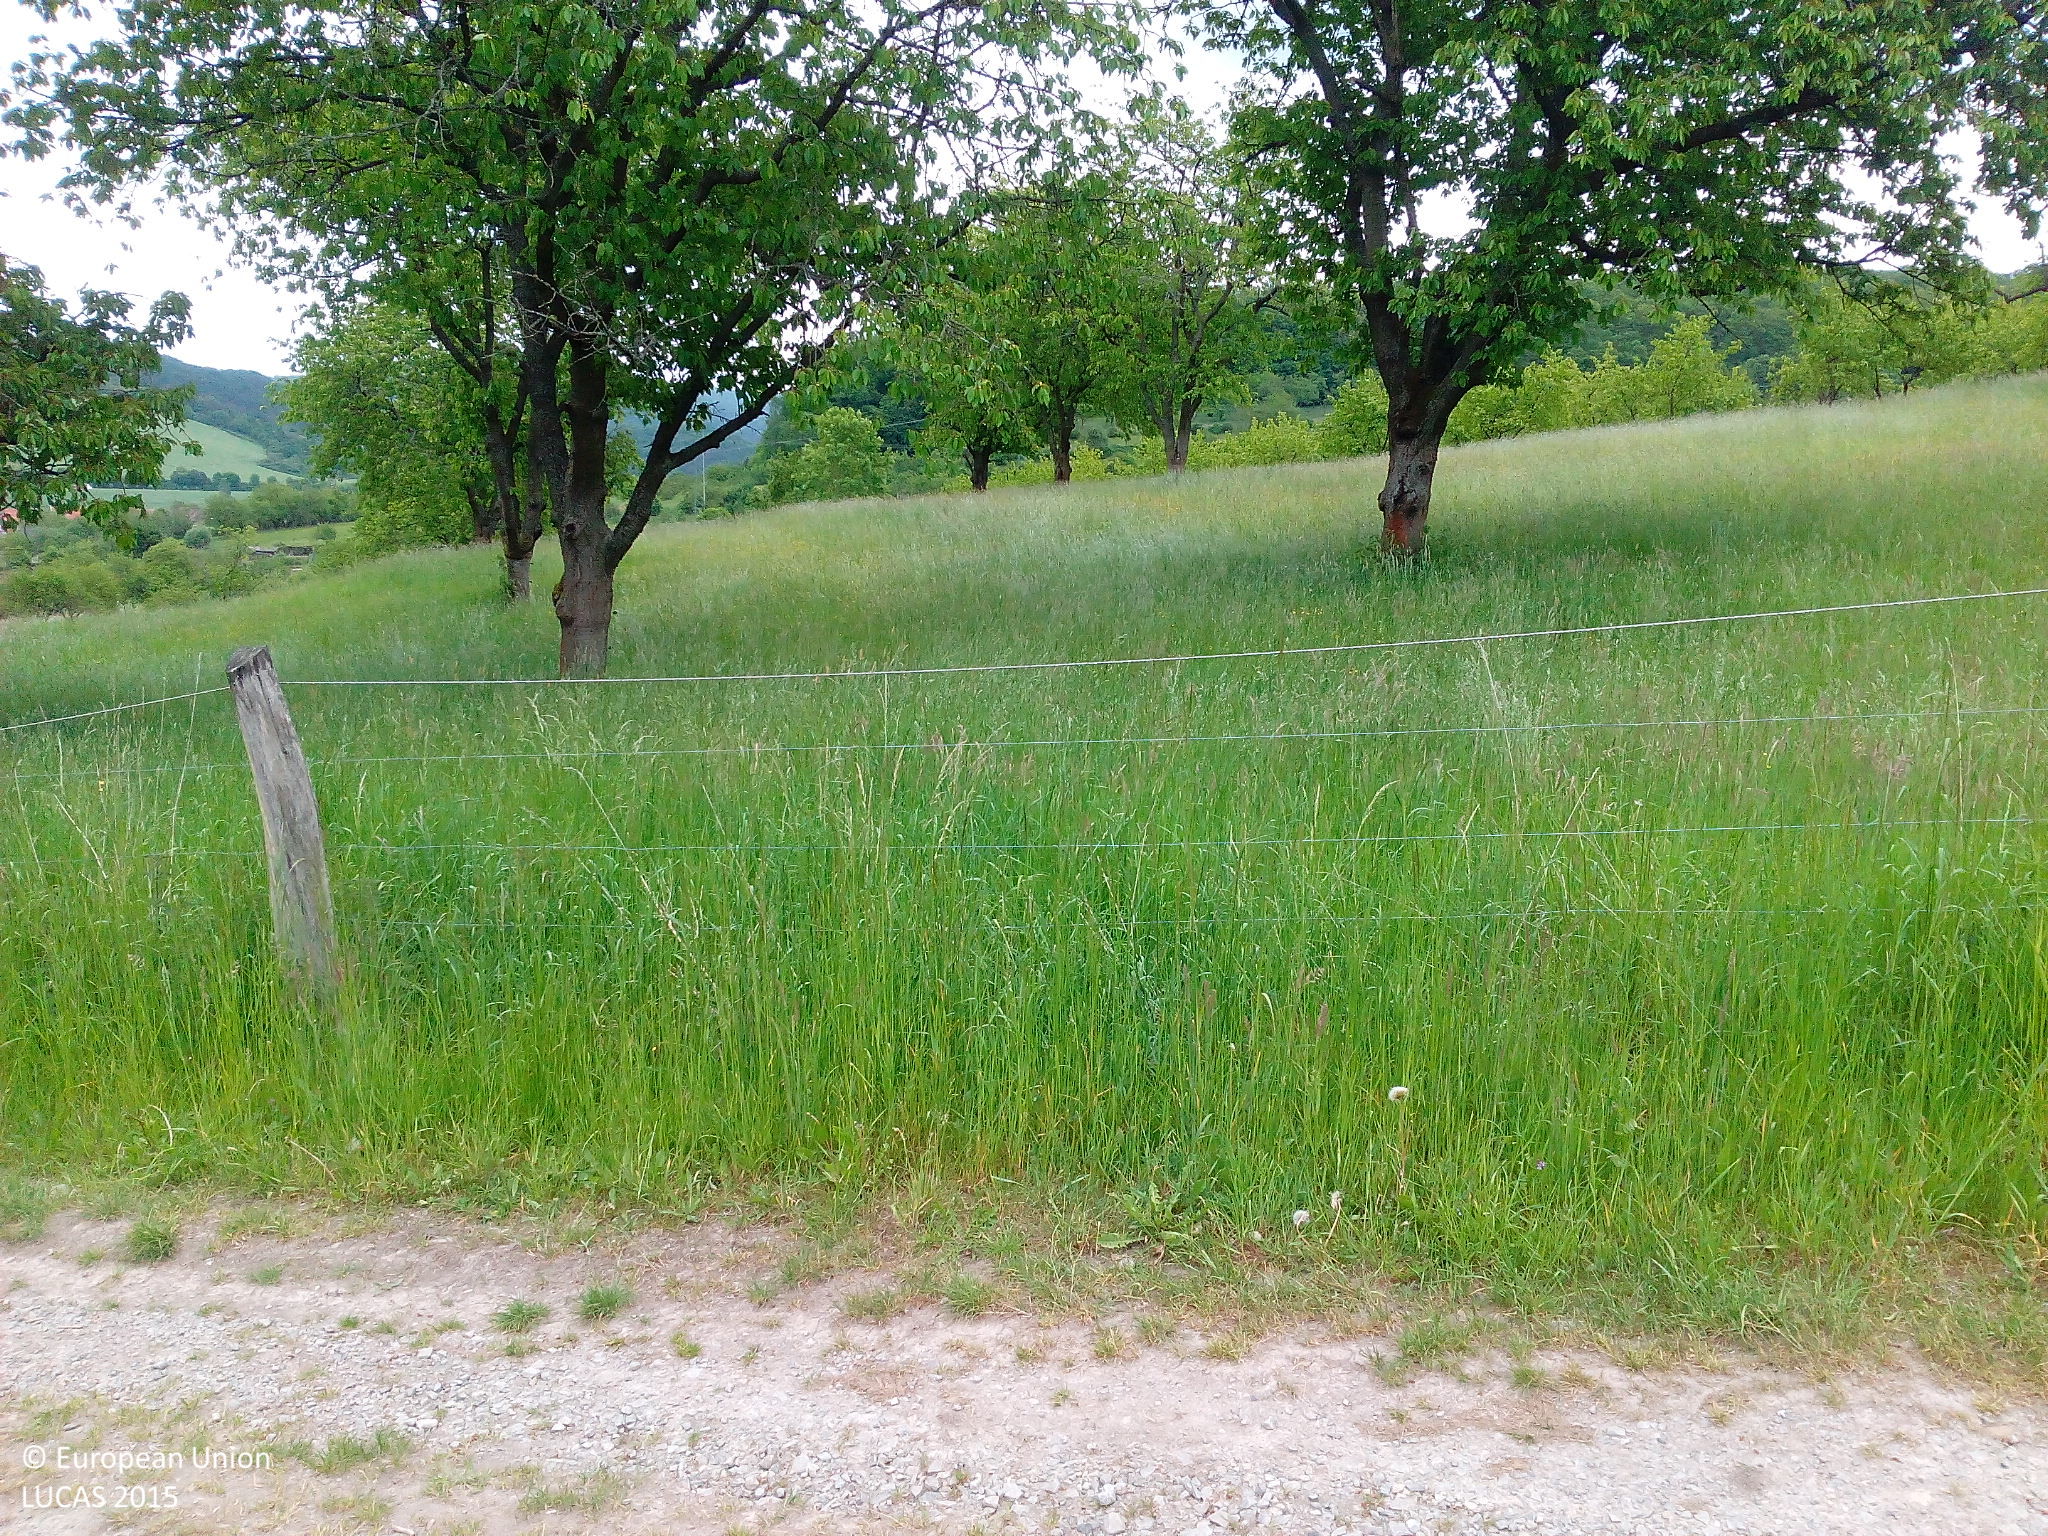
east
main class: Cropland
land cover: Cherry fruit
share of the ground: < 10 %
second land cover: Grassland without tree/shrub cover
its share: > 75 %
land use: Agriculture (excluding fallow land and kitchen gardens)
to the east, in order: Cherry fruit; Grassland without tree/shrub cover; Fences; Grass margins; Tracks; Grass margins; Fences; Cherry fruit; Grassland without tree/shrub cover; Fences; Grass margins; Tracks; Grass margins; Fences; Grassland without tree/shrub cover; Fences; Cherry fruit; Tracks; Fences; Grassland without tree/shrub cover; Cherry fruit; Grassland without tree/shrub cover; Single bushes/trees
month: May
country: DE
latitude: 51.3169
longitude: 9.8709
